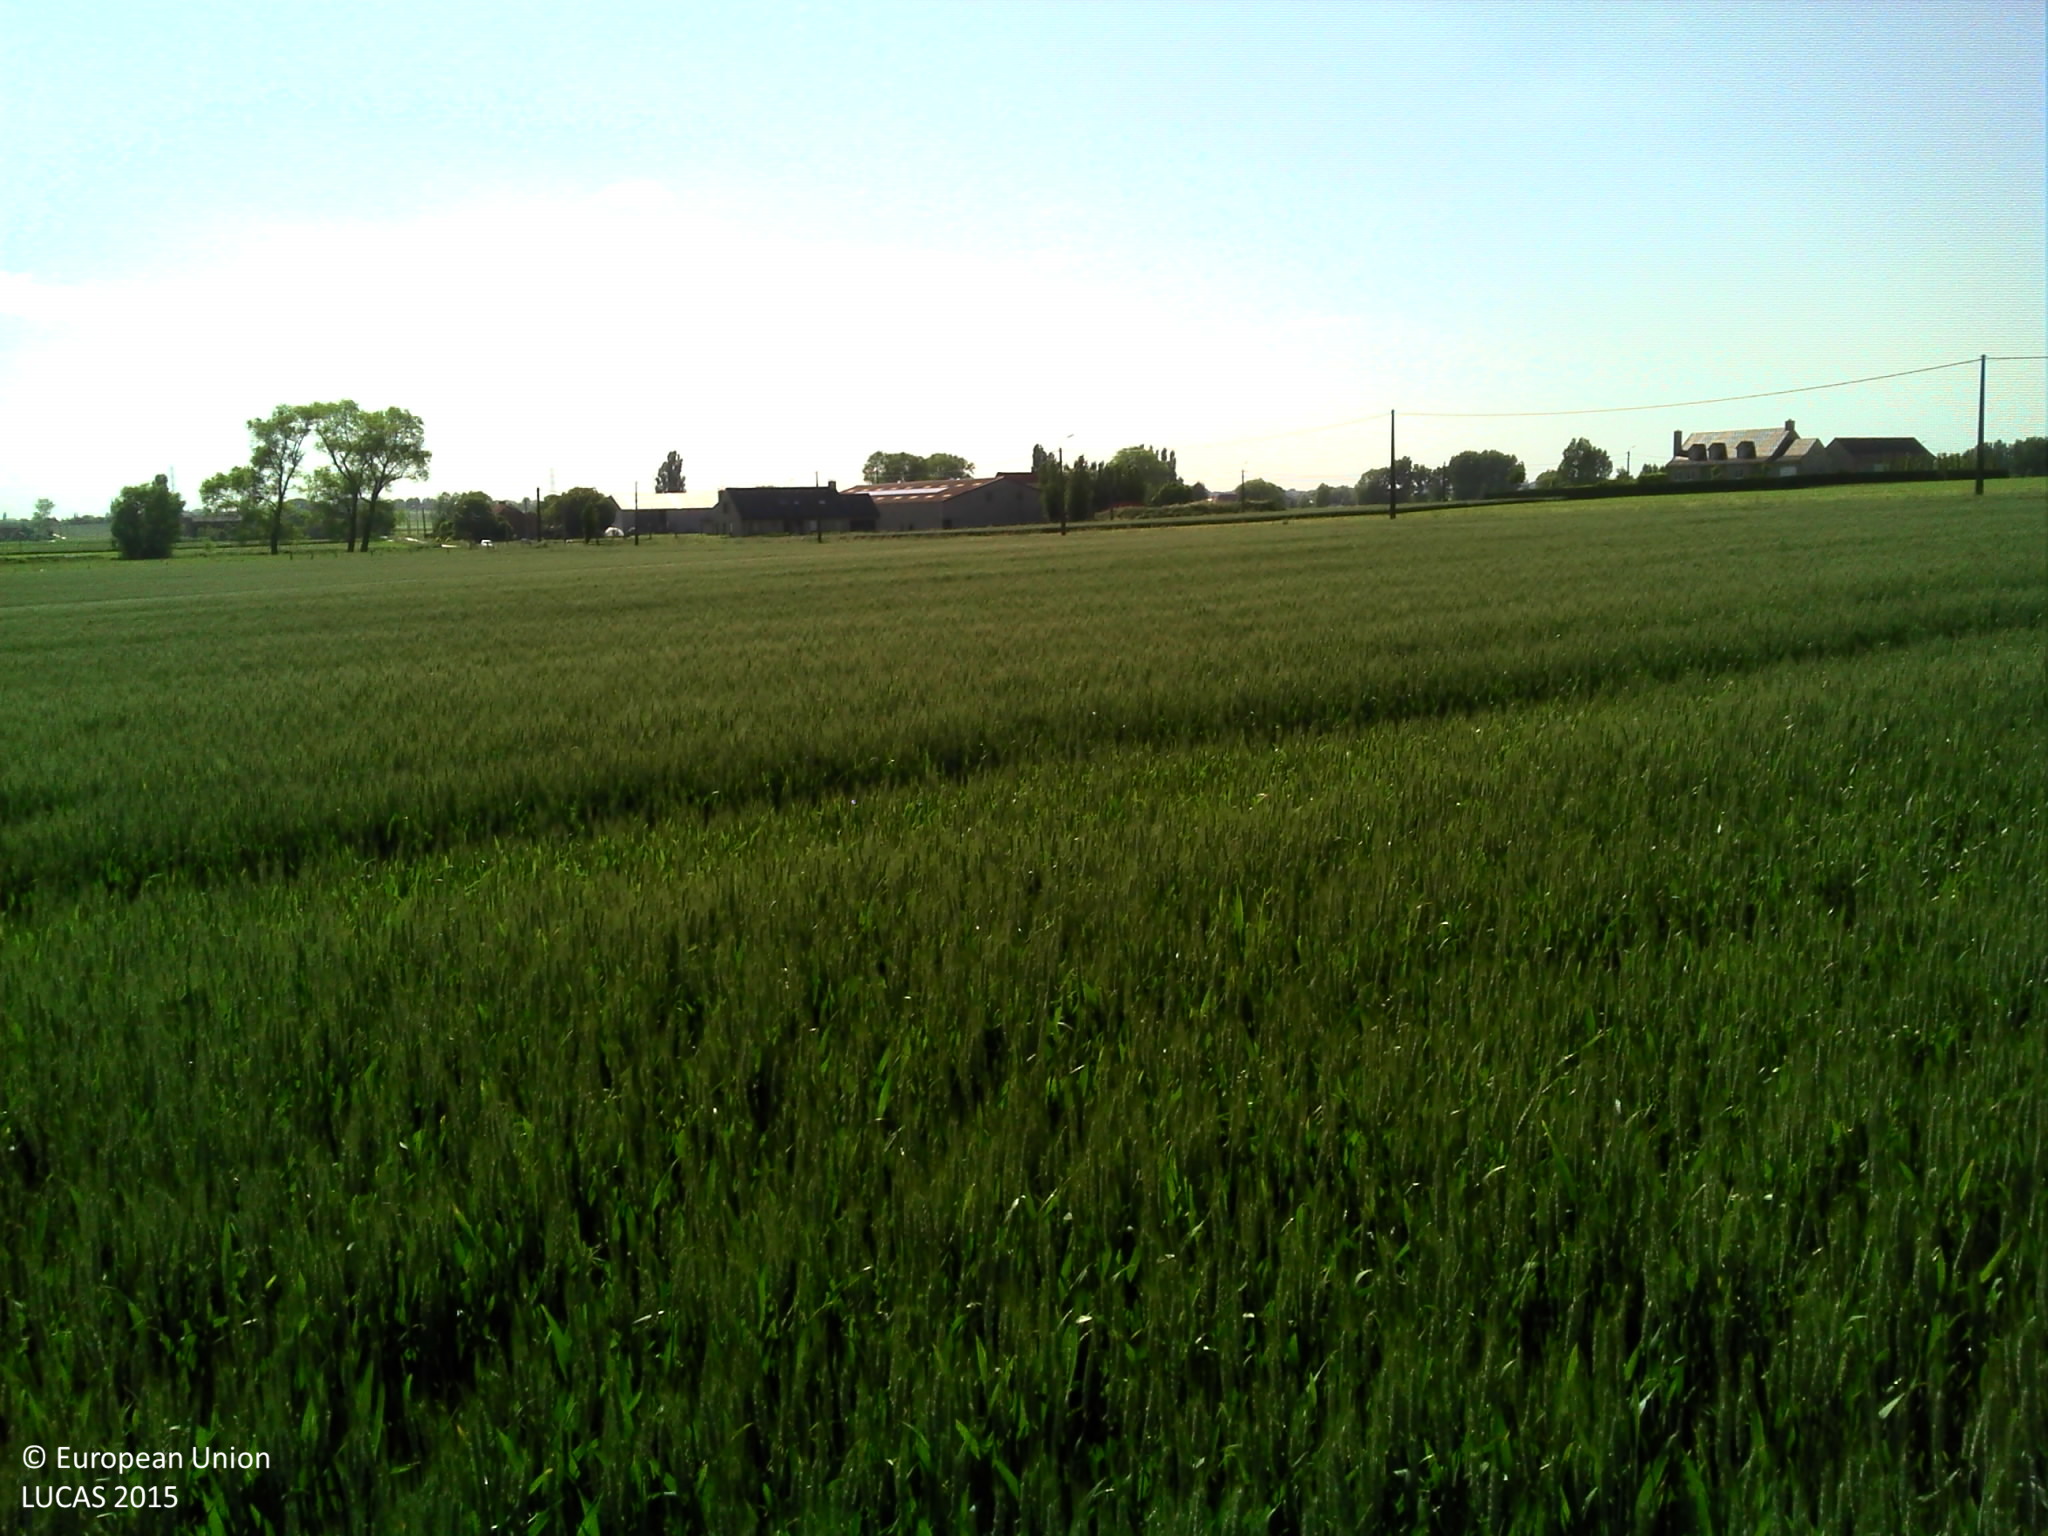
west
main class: Cropland
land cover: Common wheat
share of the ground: > 75 %
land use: Agriculture (excluding fallow land and kitchen gardens)
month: June
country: BE
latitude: 50.8578
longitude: 3.0718
